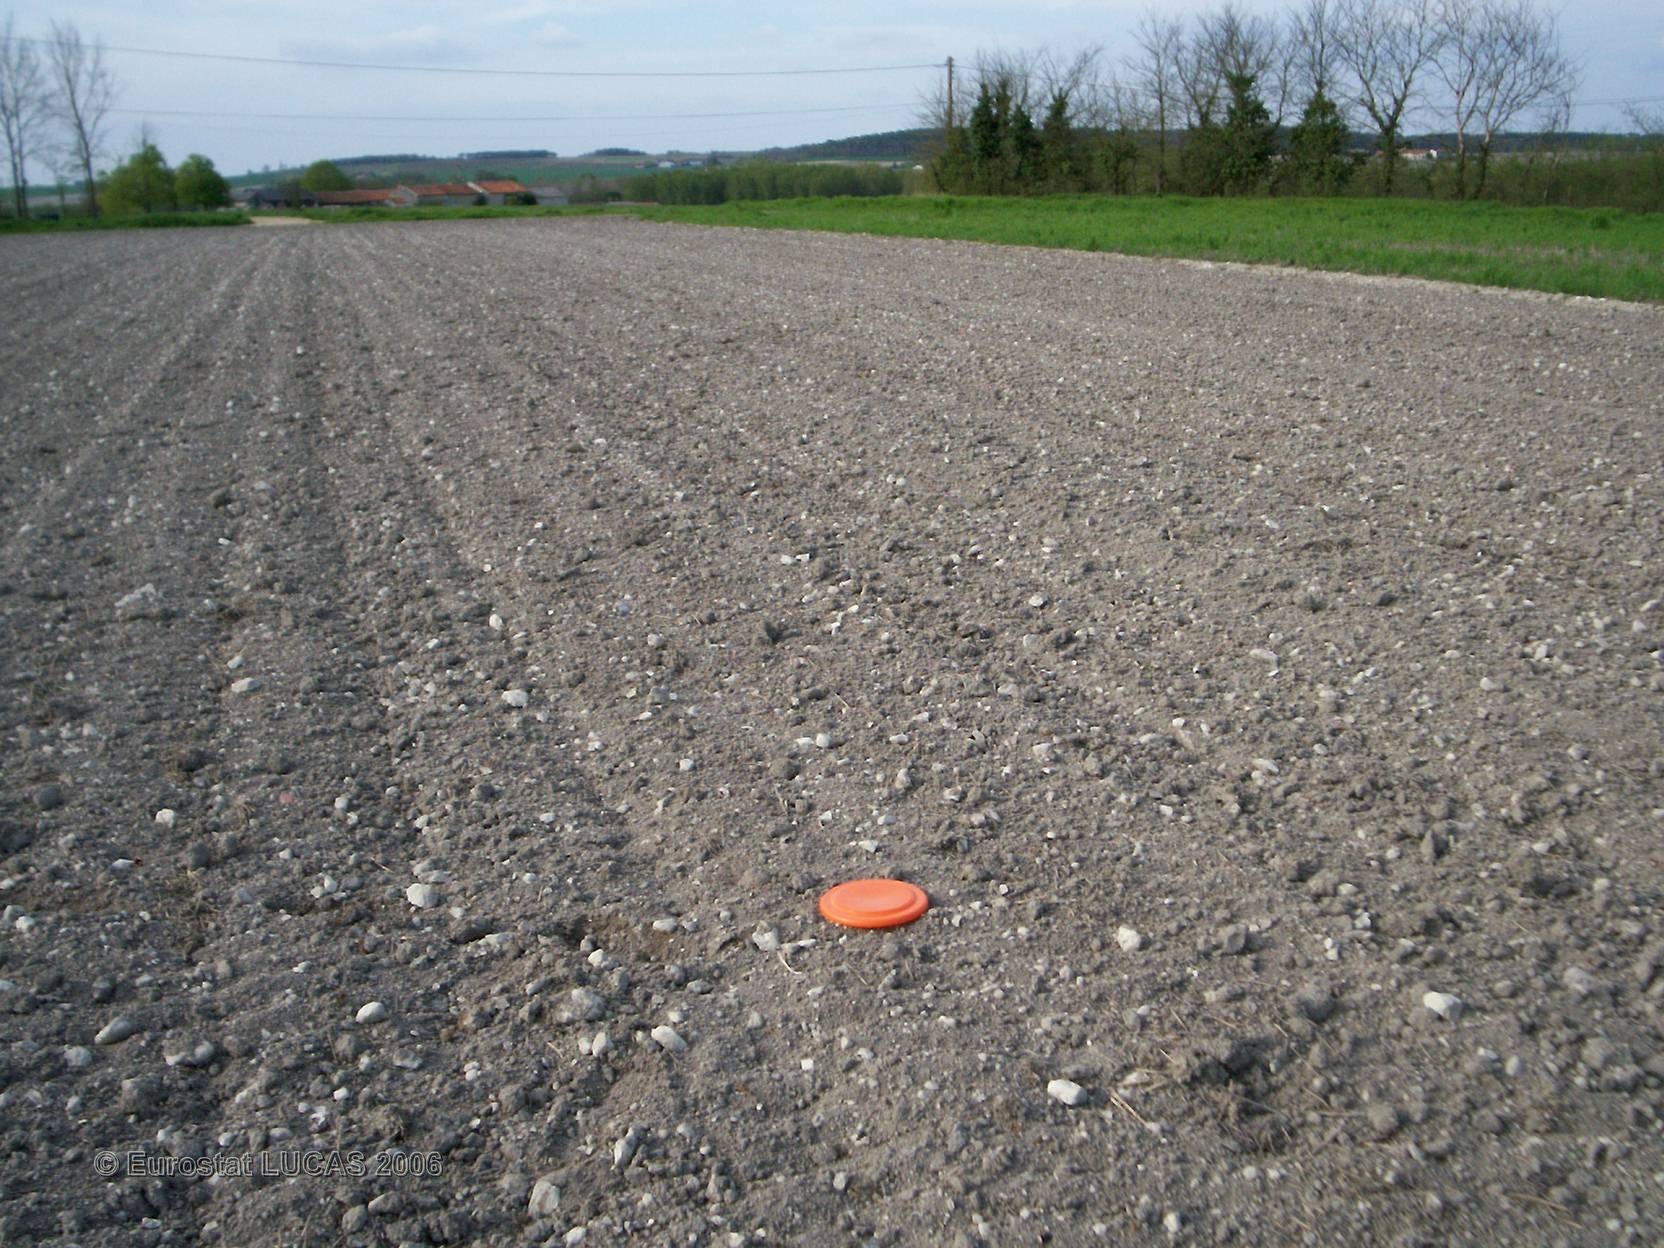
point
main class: Bare land
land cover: Bare land
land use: Agriculture (excluding fallow land and kitchen gardens)
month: April
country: FR
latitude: 46.9520
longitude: 0.4012
